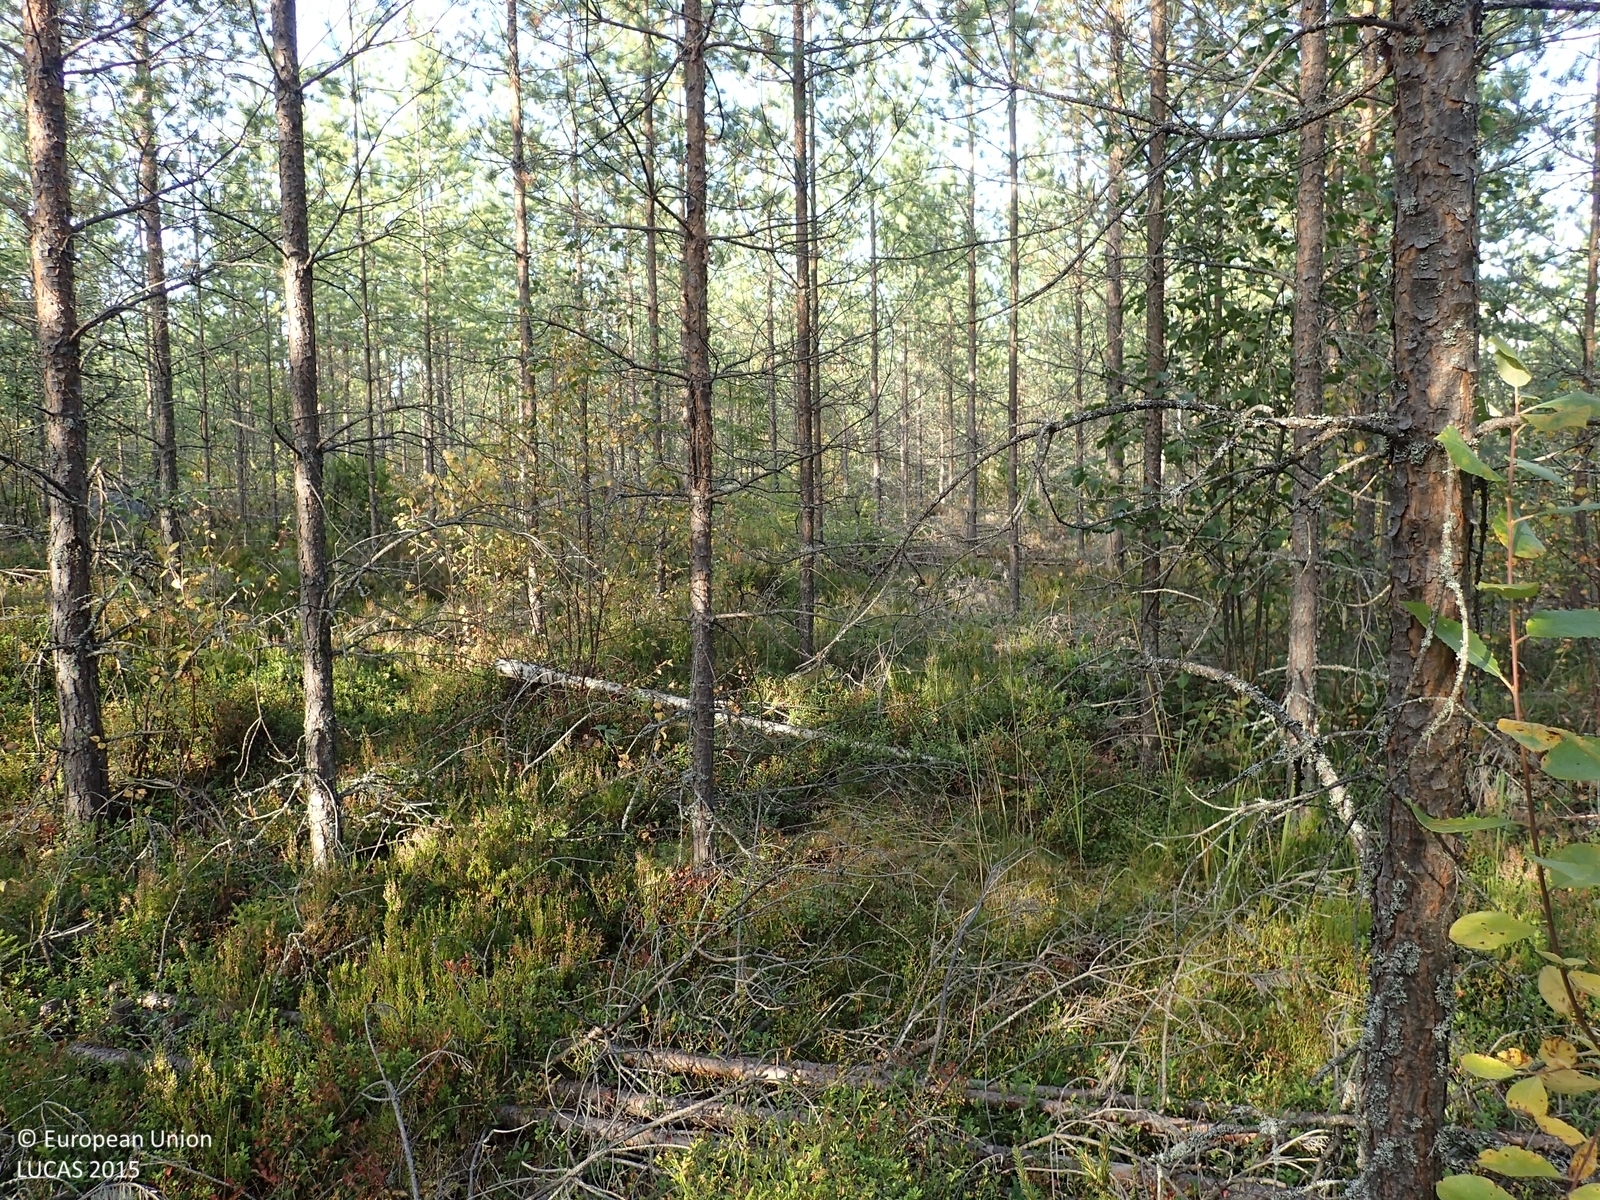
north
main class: Woodland
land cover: Pine dominated mixed woodland
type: boreal forest
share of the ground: > 75 %
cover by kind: coniferous forest trees 60 %, broadleaved forest trees 20 %, shrubs 20 %
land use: Forestry
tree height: < 5 m
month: September
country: FI
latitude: 63.0340
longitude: 25.5452
